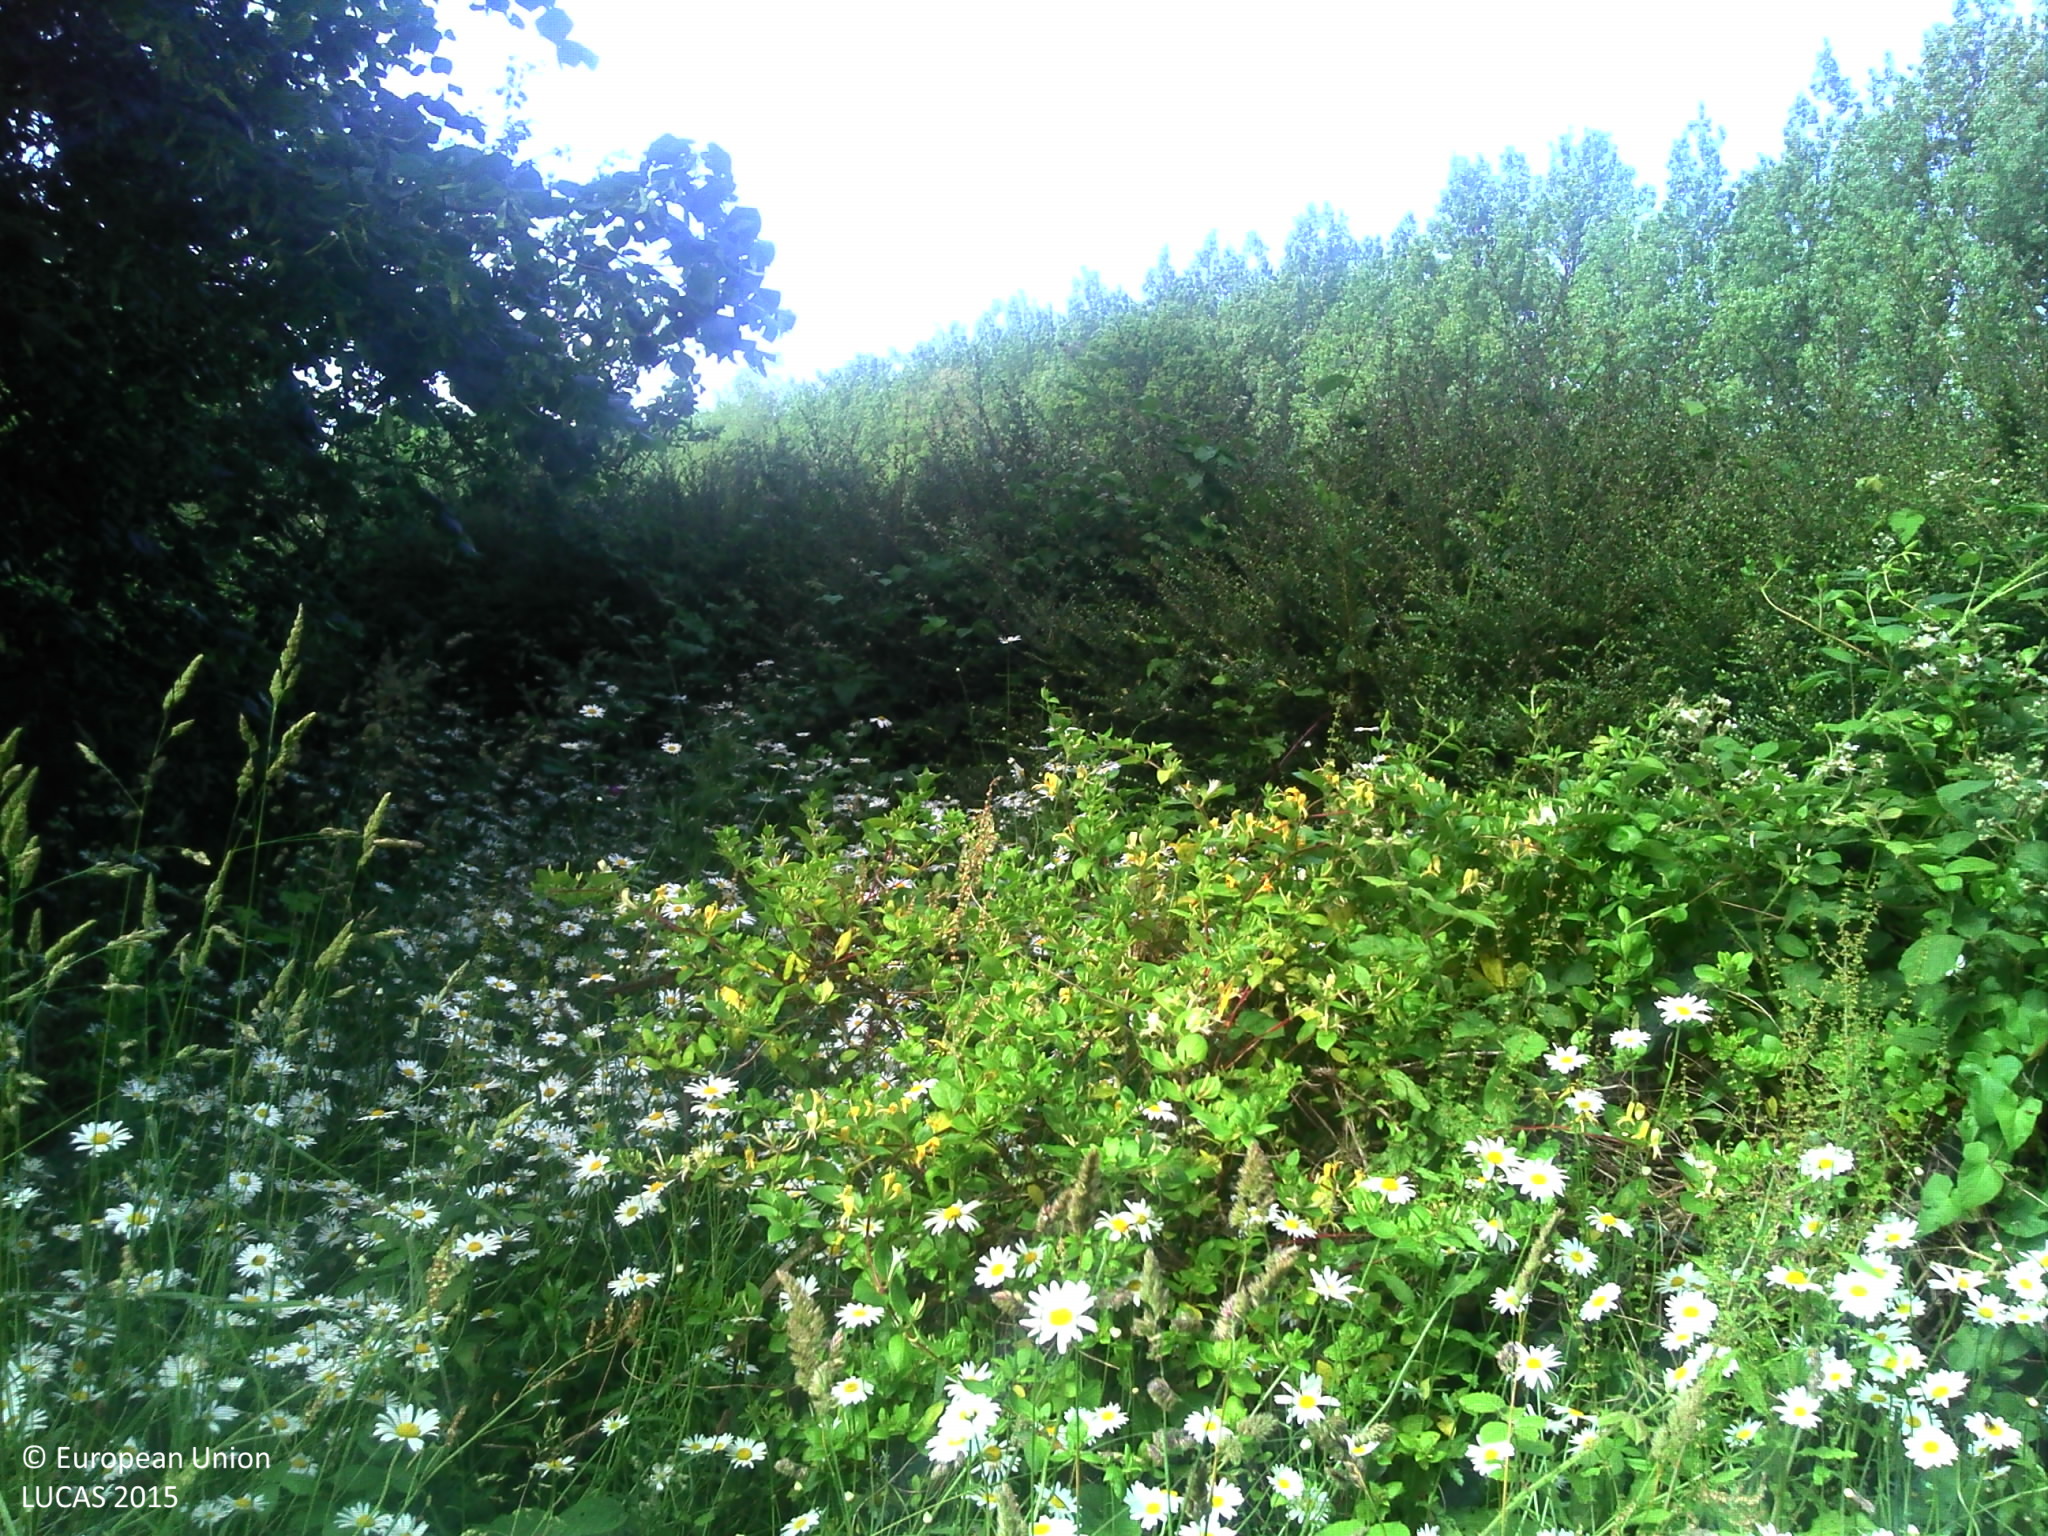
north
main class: Grassland
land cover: Grassland with sparse tree/shrub cover
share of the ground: > 75 %
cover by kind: herbaceous plants 95 %, broadleaved forest trees 5 %
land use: Semi-natural and natural areas not in use
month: June
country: FR
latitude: 49.4114
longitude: -1.3912
